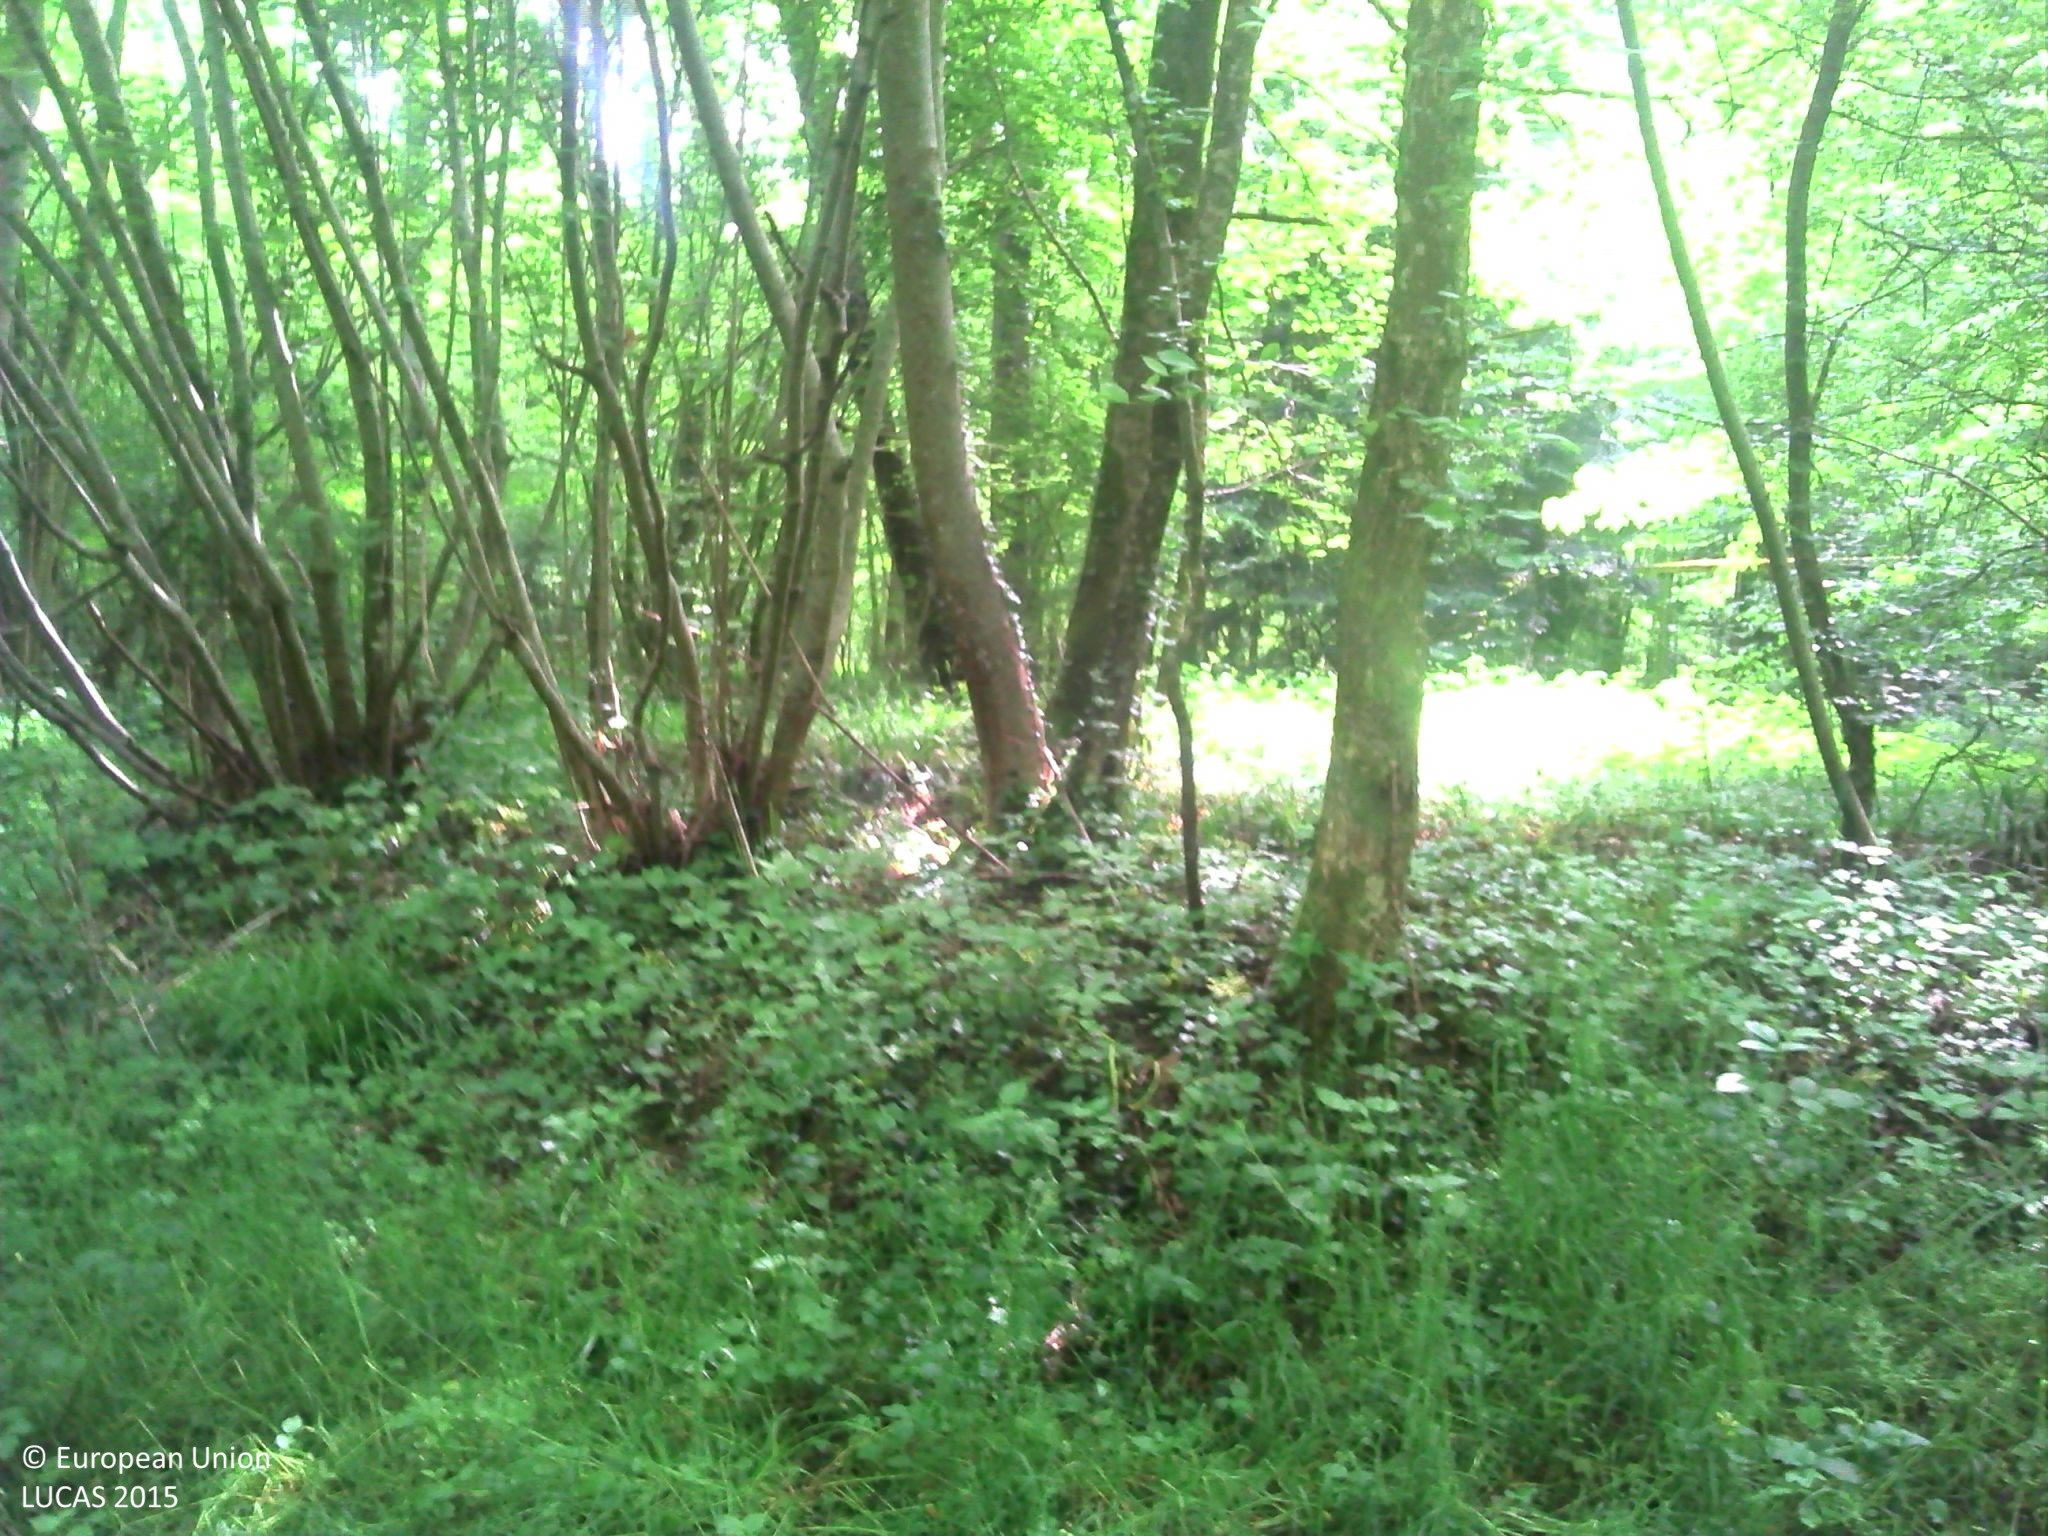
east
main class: Woodland
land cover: Broadleaved woodland
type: mesophytic deciduous forest
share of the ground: > 75 %
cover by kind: broadleaved forest trees 85 %, herbaceous plants 10 %, coniferous forest trees 5 %
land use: Forestry
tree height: > 5 m
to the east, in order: Broadleaved woodland; Tracks; Broadleaved woodland; Ditches and canals; Broadleaved woodland; Tracks; Broadleaved woodland; Ditches and canals; Broadleaved woodland; Ditches and canals; Broadleaved woodland; Ditches and canals; Broadleaved woodland; Tracks; Broadleaved woodland; Ditches and canals; Broadleaved woodland
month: May
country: FR
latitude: 48.6660
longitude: 4.9334
